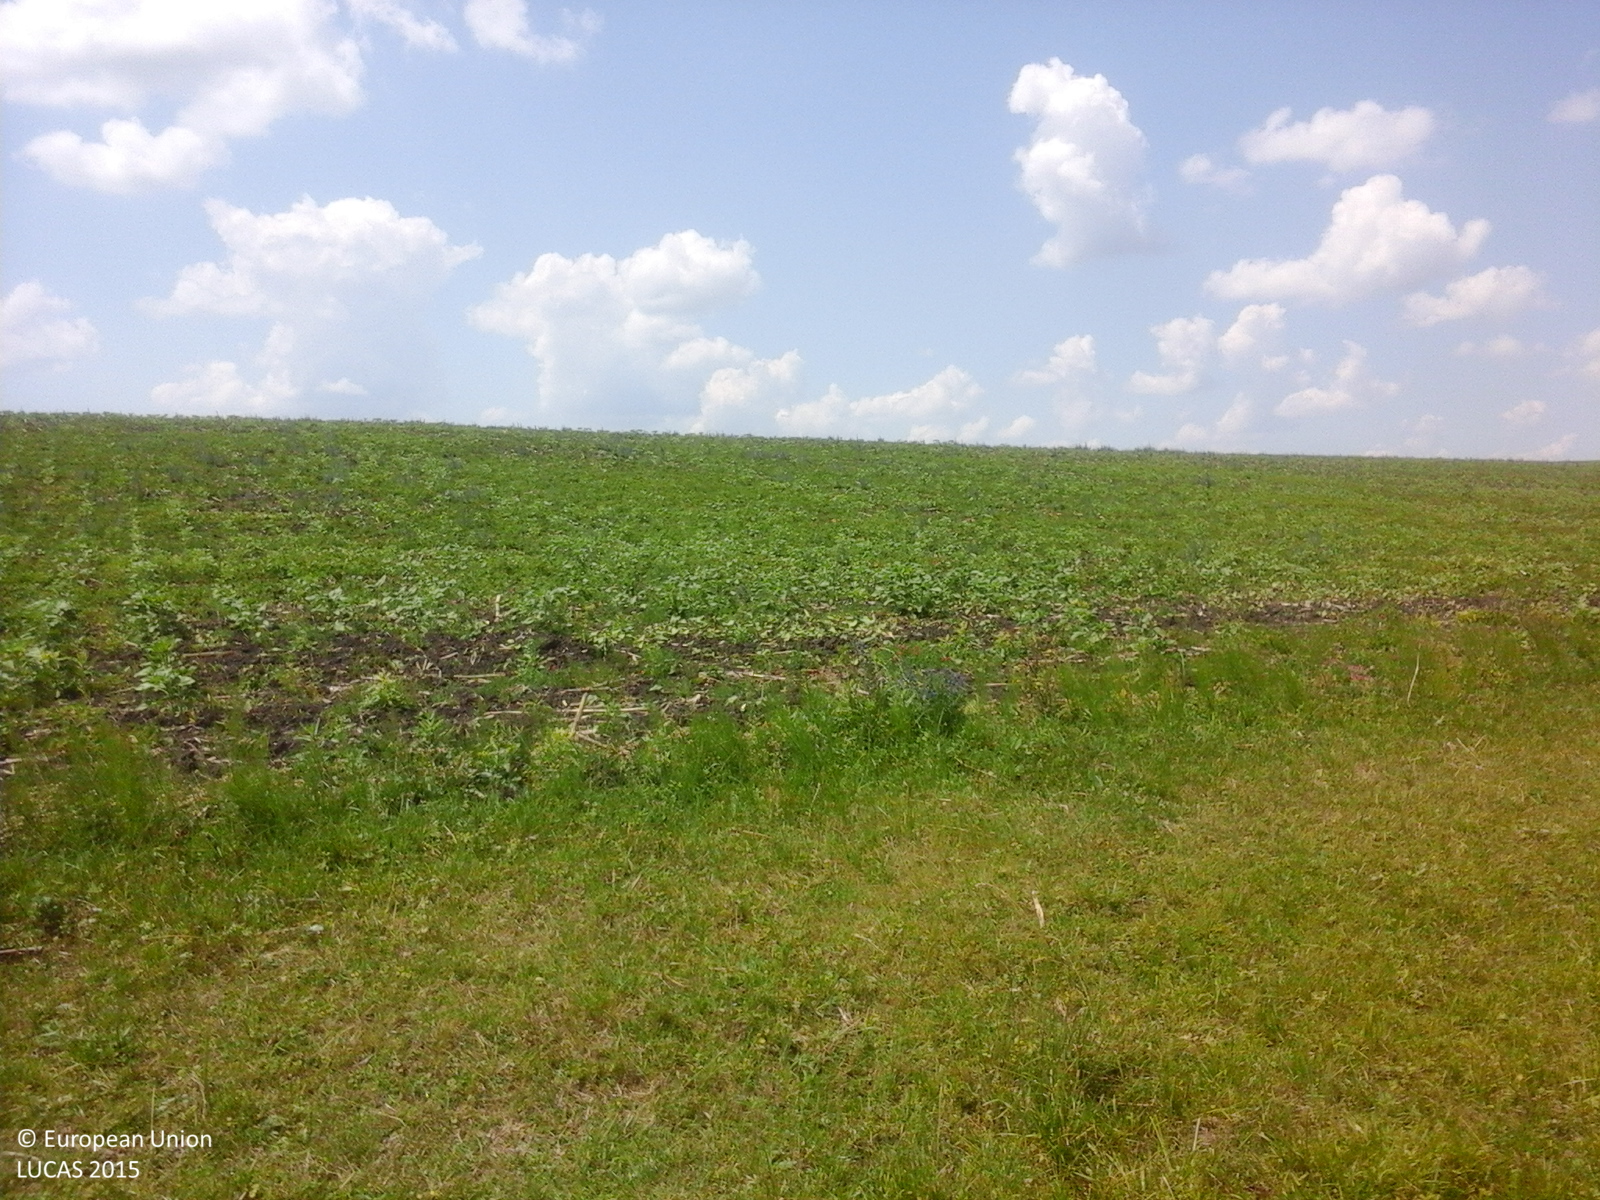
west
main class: Grassland
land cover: Grassland without tree/shrub cover
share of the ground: > 75 %
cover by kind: herbaceous plants 100 %
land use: Agriculture (excluding fallow land and kitchen gardens)
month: June
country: RO
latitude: 48.0281
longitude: 26.6578
